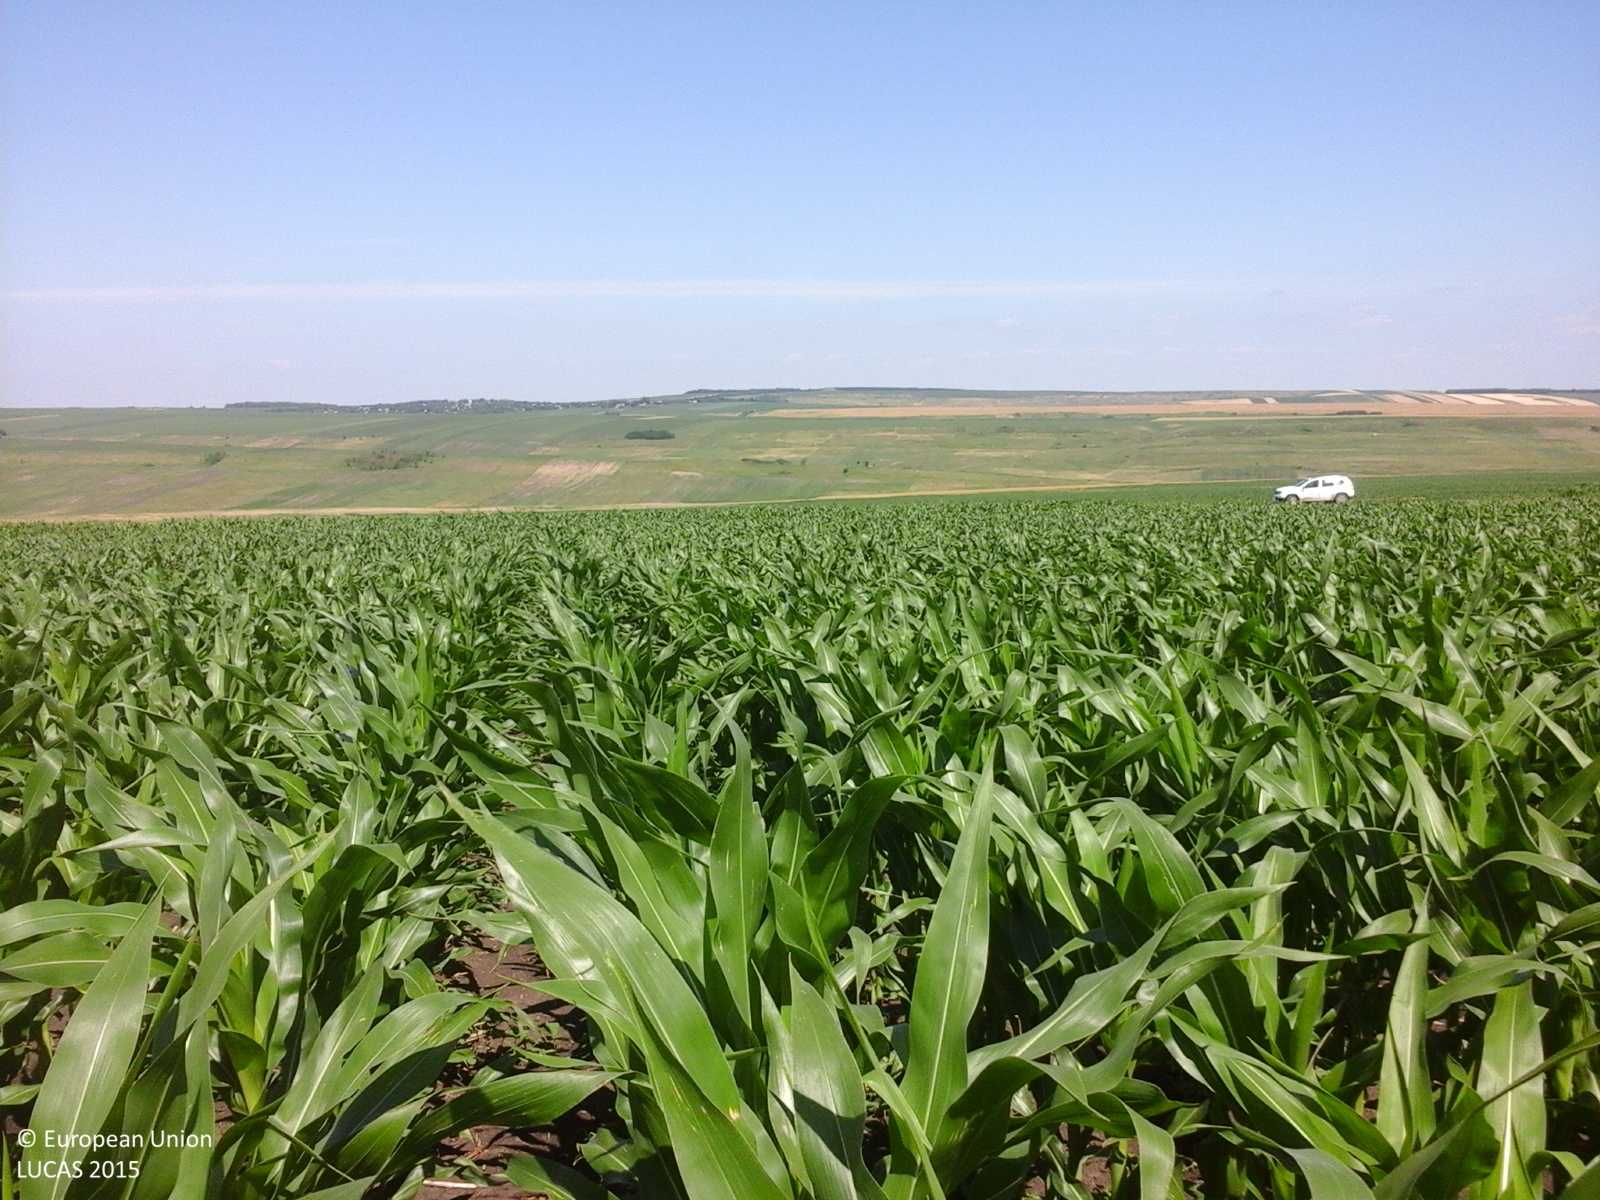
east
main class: Cropland
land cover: Maize
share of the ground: > 75 %
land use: Agriculture (excluding fallow land and kitchen gardens)
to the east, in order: Maize; Grass margins; Tracks; Grass margins; Soya; Maize
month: June
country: RO
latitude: 47.5284
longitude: 27.1490
